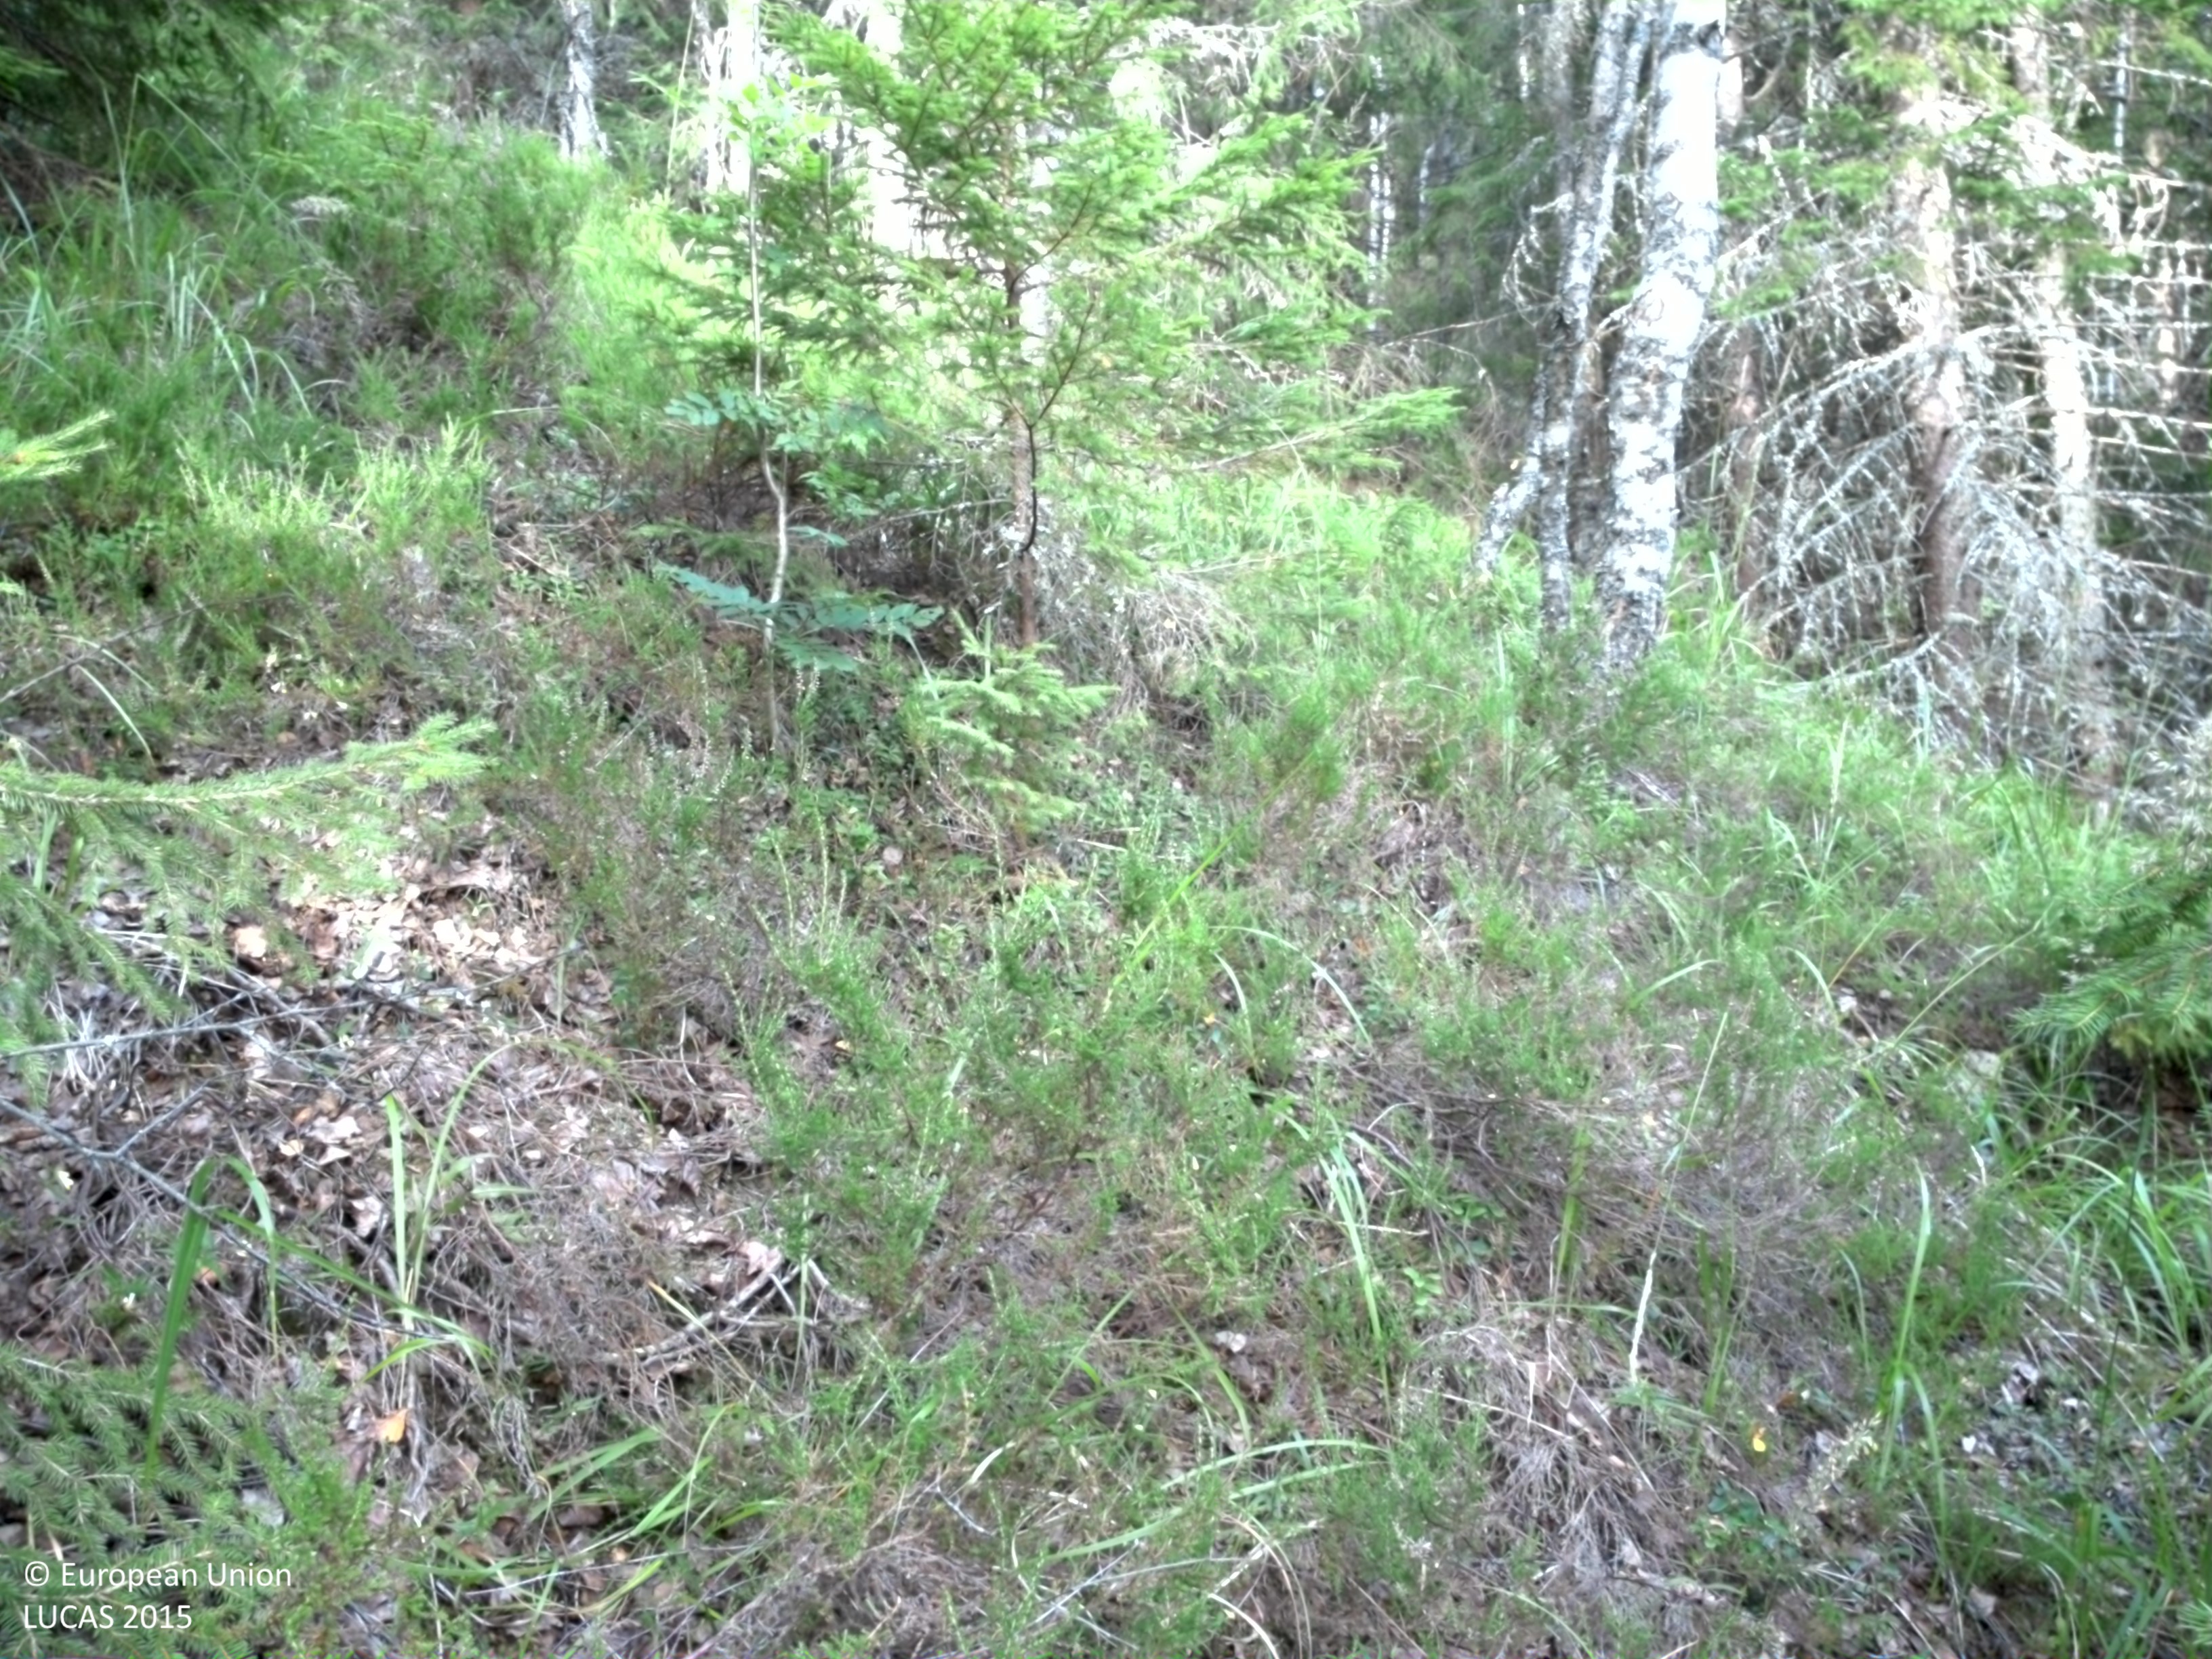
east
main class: Woodland
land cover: Spruce dominated mixed woodland
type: boreal forest
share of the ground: 50 - 75 %
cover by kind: coniferous forest trees 35 %, herbaceous plants 30 %, broadleaved forest trees 15 %, consolidated bare surface 10 %, shrubs 5 %, lichens and mosses 5 %
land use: Forestry
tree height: > 5 m
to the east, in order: Spruce dominated mixed woodland; Spruce dominated coniferous woodland; Pine dominated coniferous woodland
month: August
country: SE
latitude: 60.0088
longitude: 14.2404
